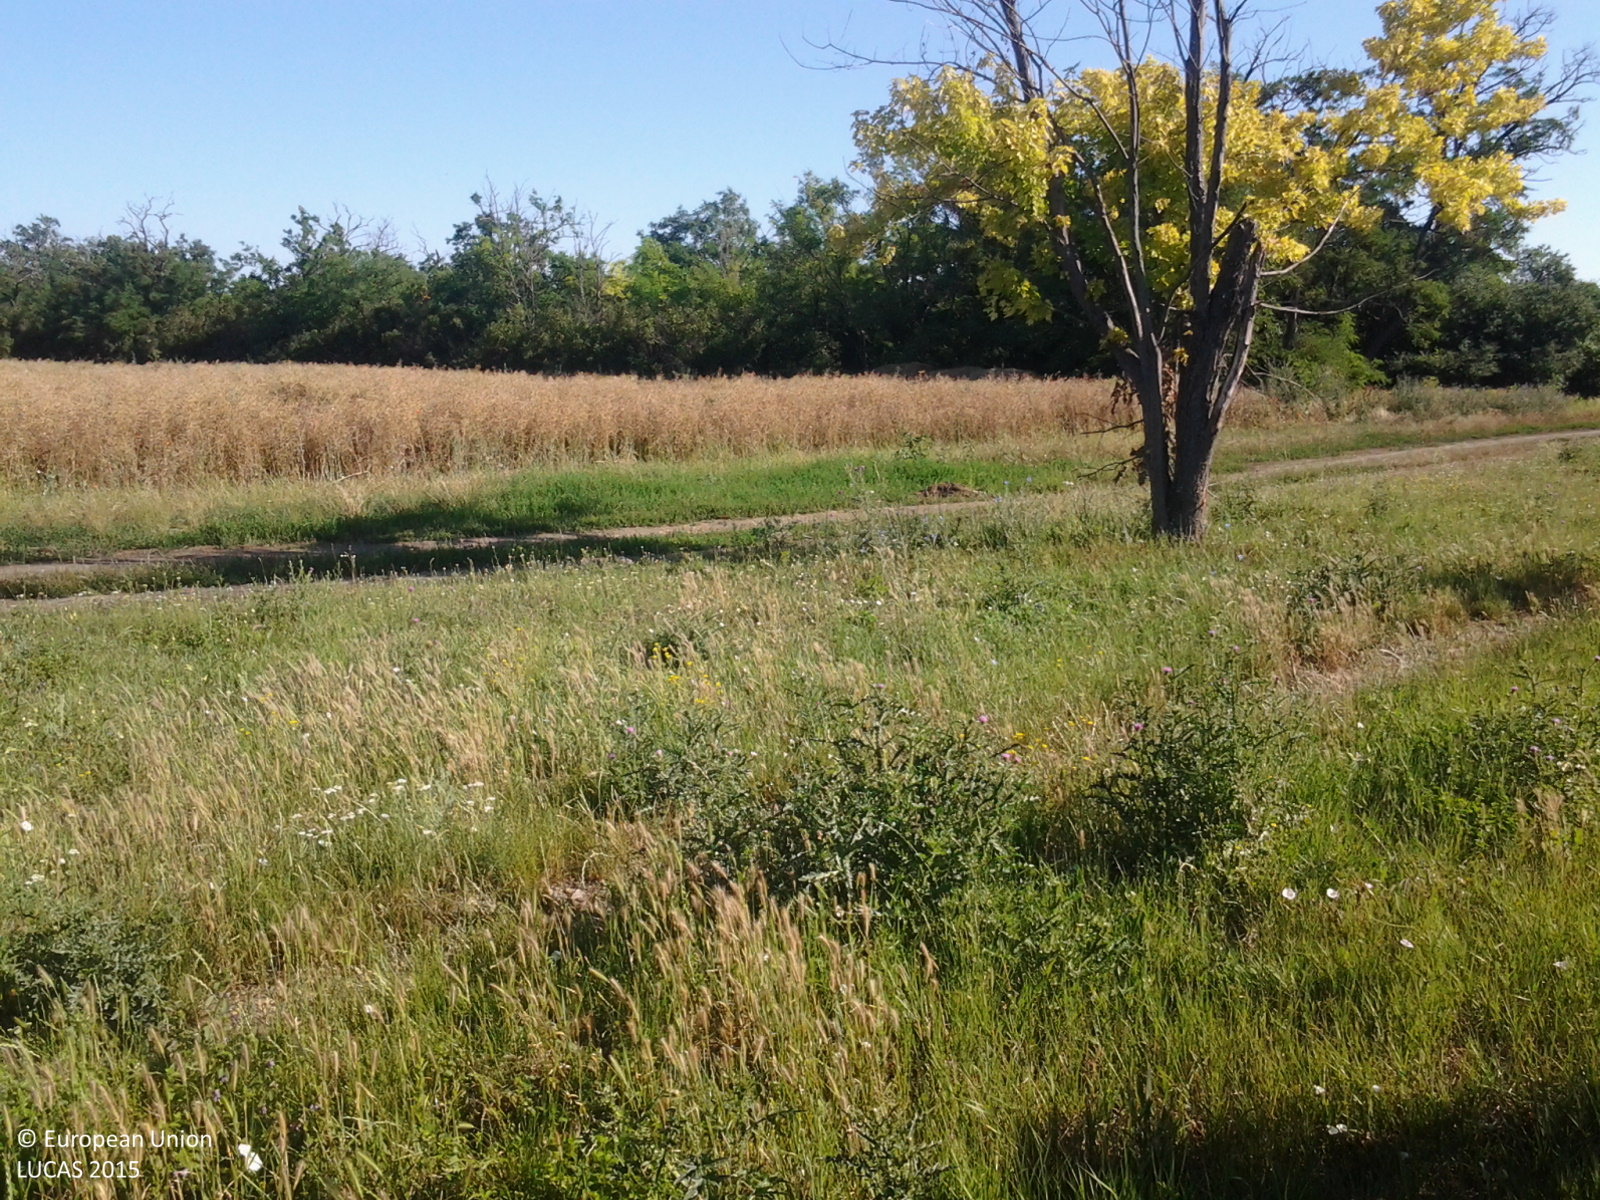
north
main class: Woodland
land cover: Broadleaved woodland
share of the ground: 10 - 25 %
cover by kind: herbaceous plants 75 %, broadleaved forest trees 15 %, shrubs 10 %
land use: Forestry
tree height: > 5 m
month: July
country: HU
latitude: 47.0702
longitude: 20.4714
